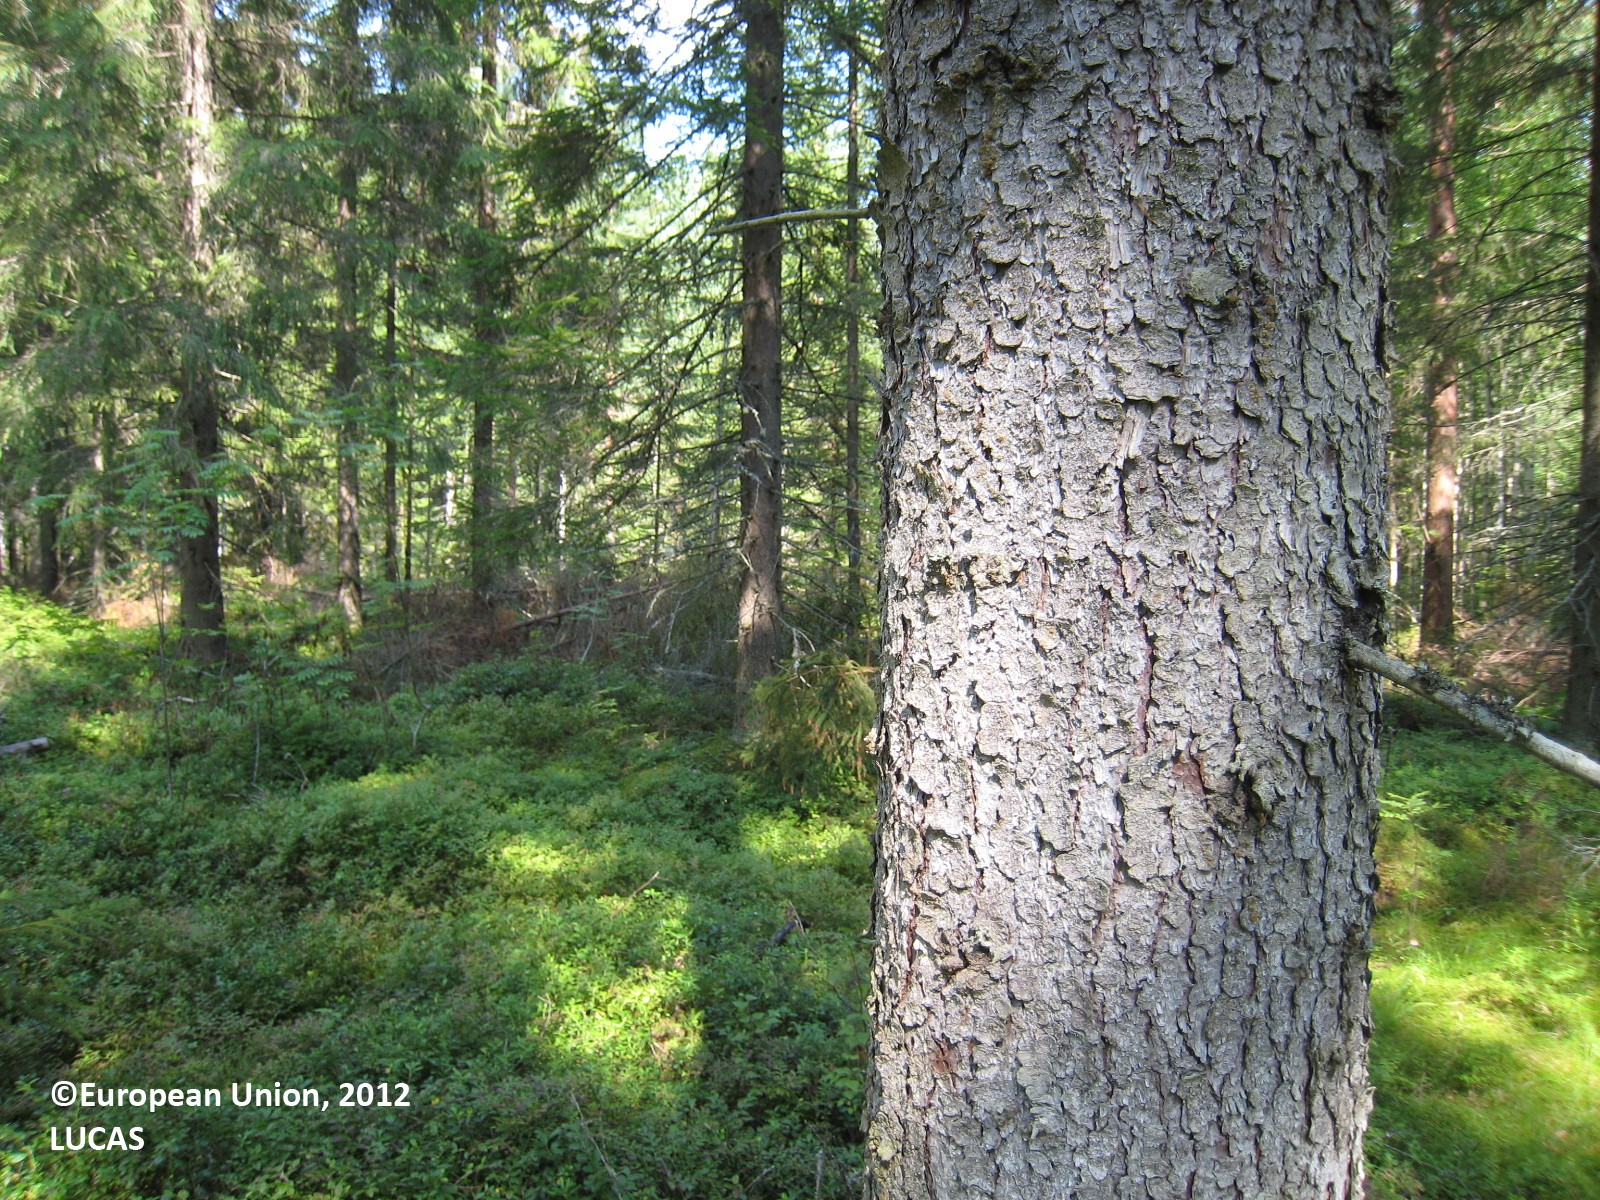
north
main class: Woodland
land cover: Spruce dominated coniferous woodland
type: boreal forest
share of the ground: 50 - 75 %
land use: Forestry
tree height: > 5 m
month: July
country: FI
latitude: 61.7901
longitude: 26.1205
